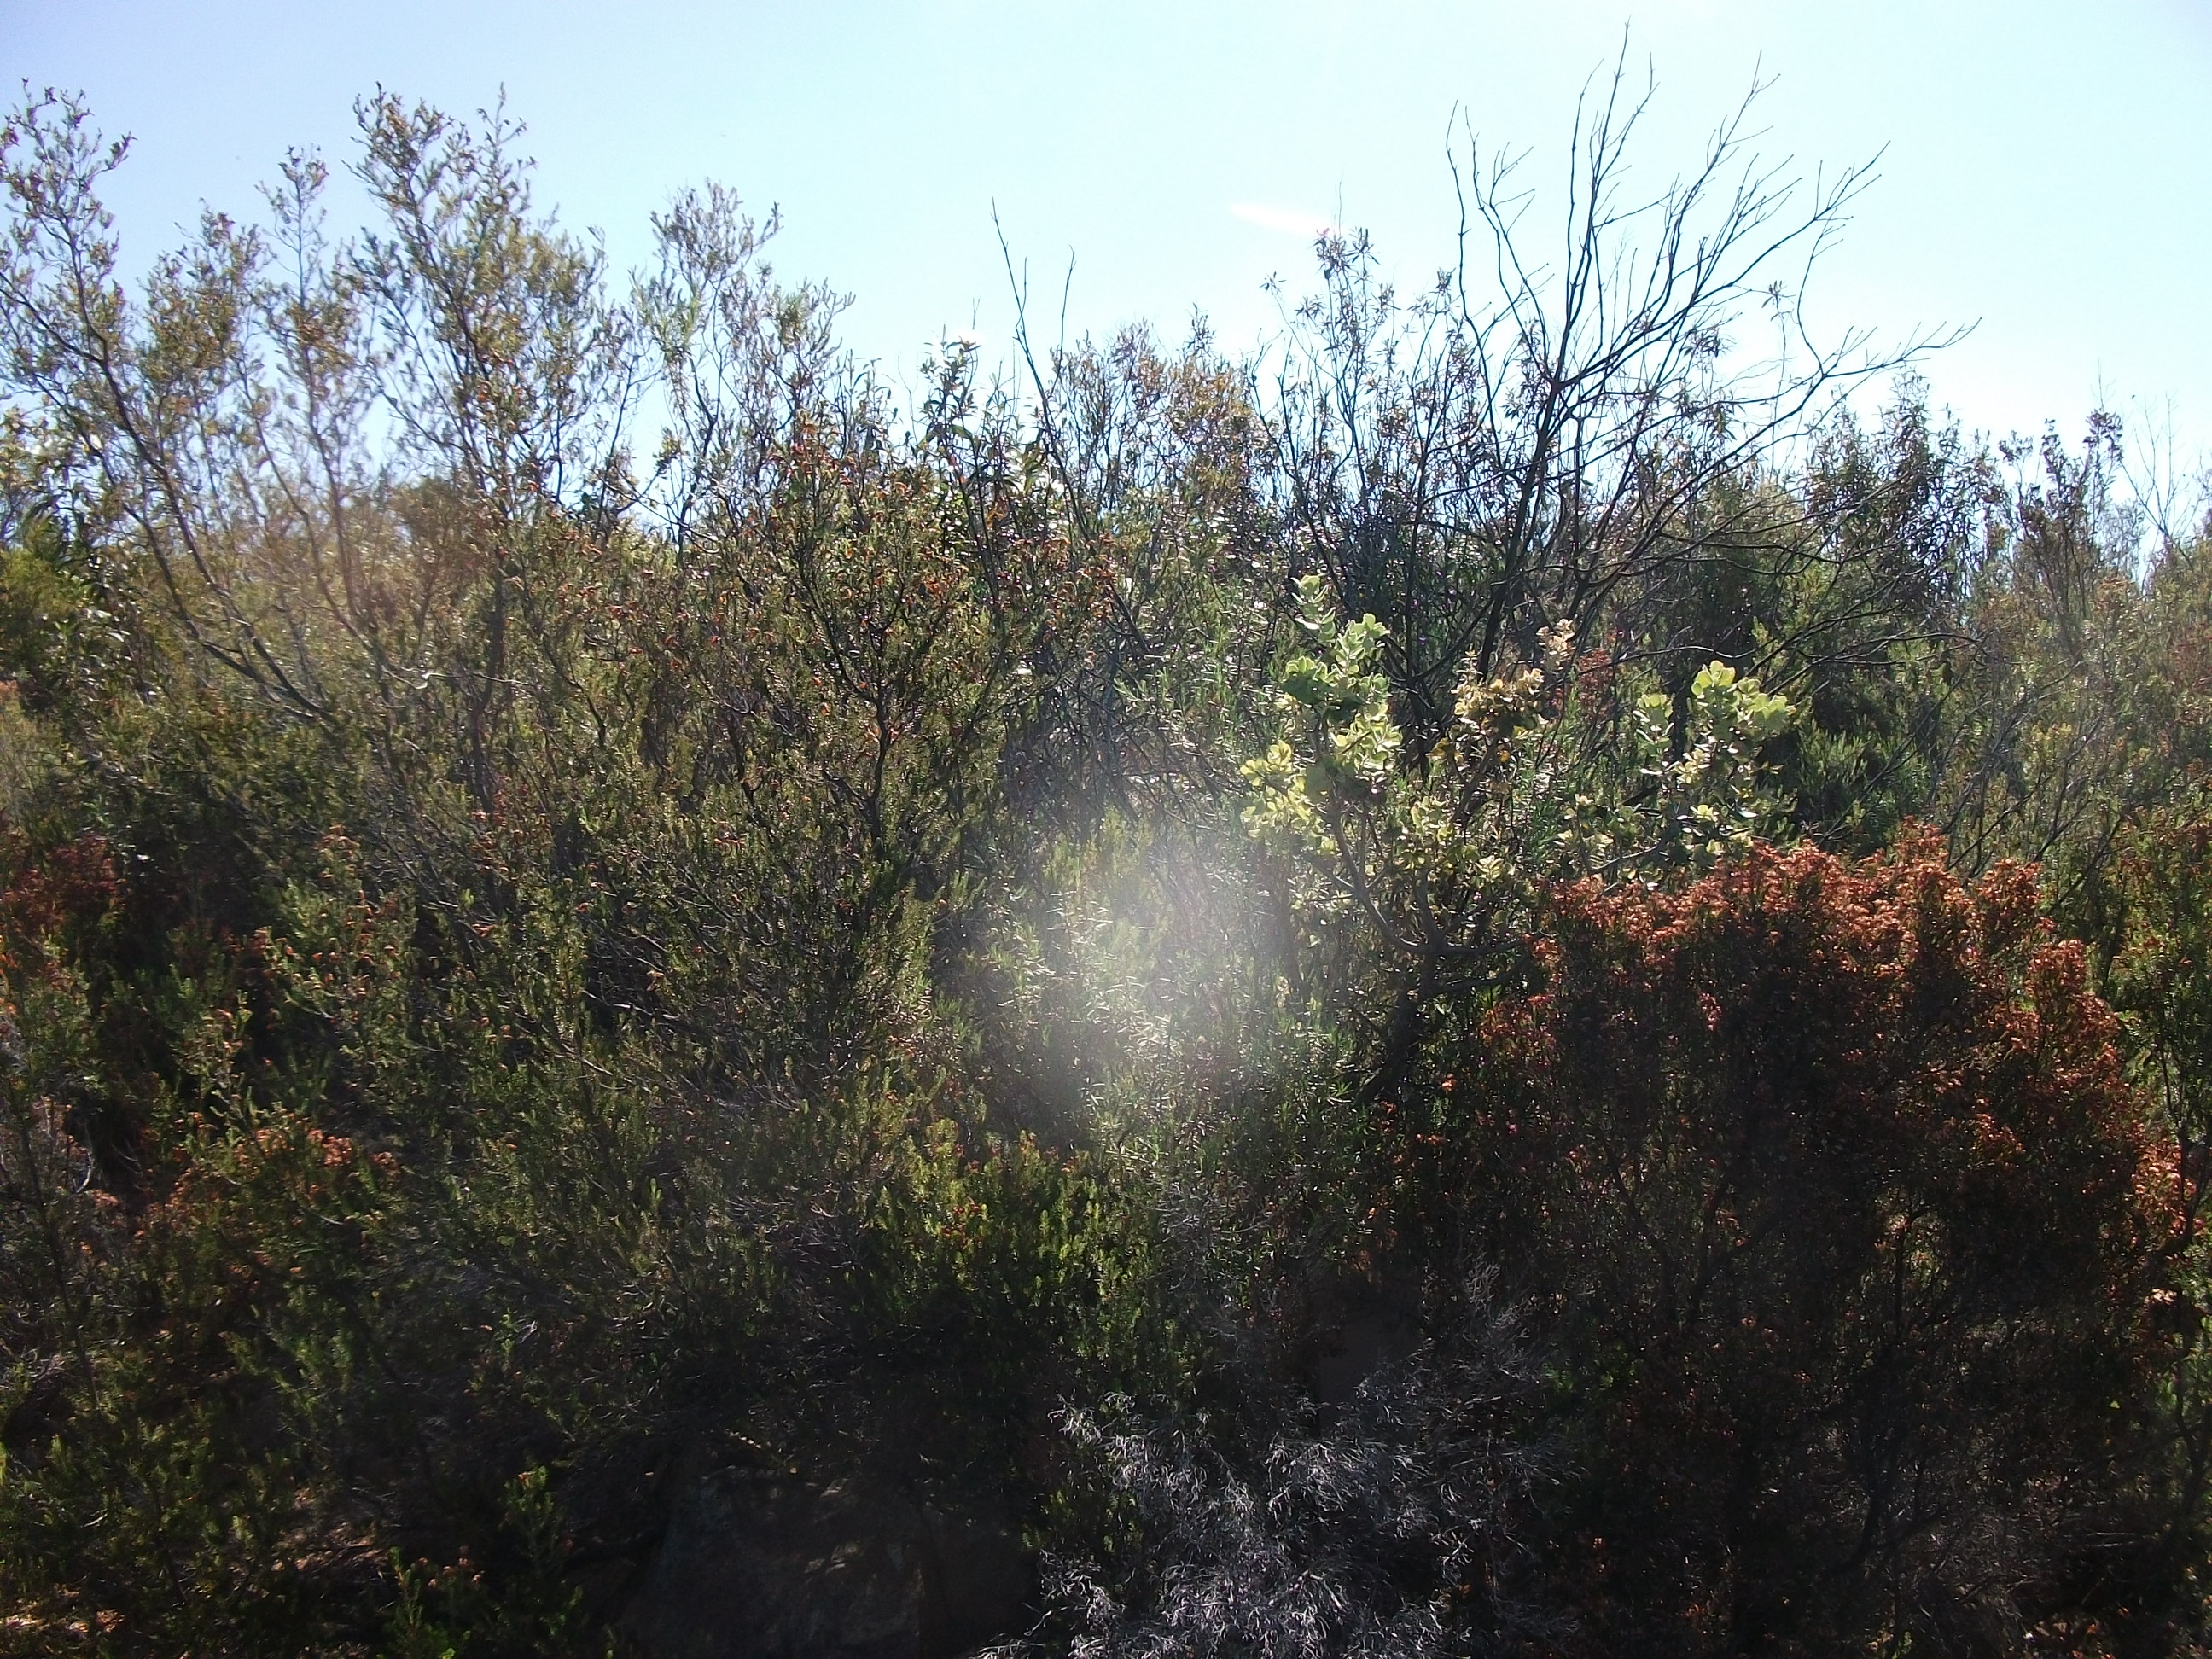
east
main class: Shrubland
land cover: Shrubland without tree cover
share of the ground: > 75 %
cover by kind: shrubs 95 %, unconsolidated bare surface 5 %
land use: Semi-natural and natural areas not in use
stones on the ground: 10 - 25 %
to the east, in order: Shrubland without tree cover
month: April
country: ES
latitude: 37.8501
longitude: -6.5787
